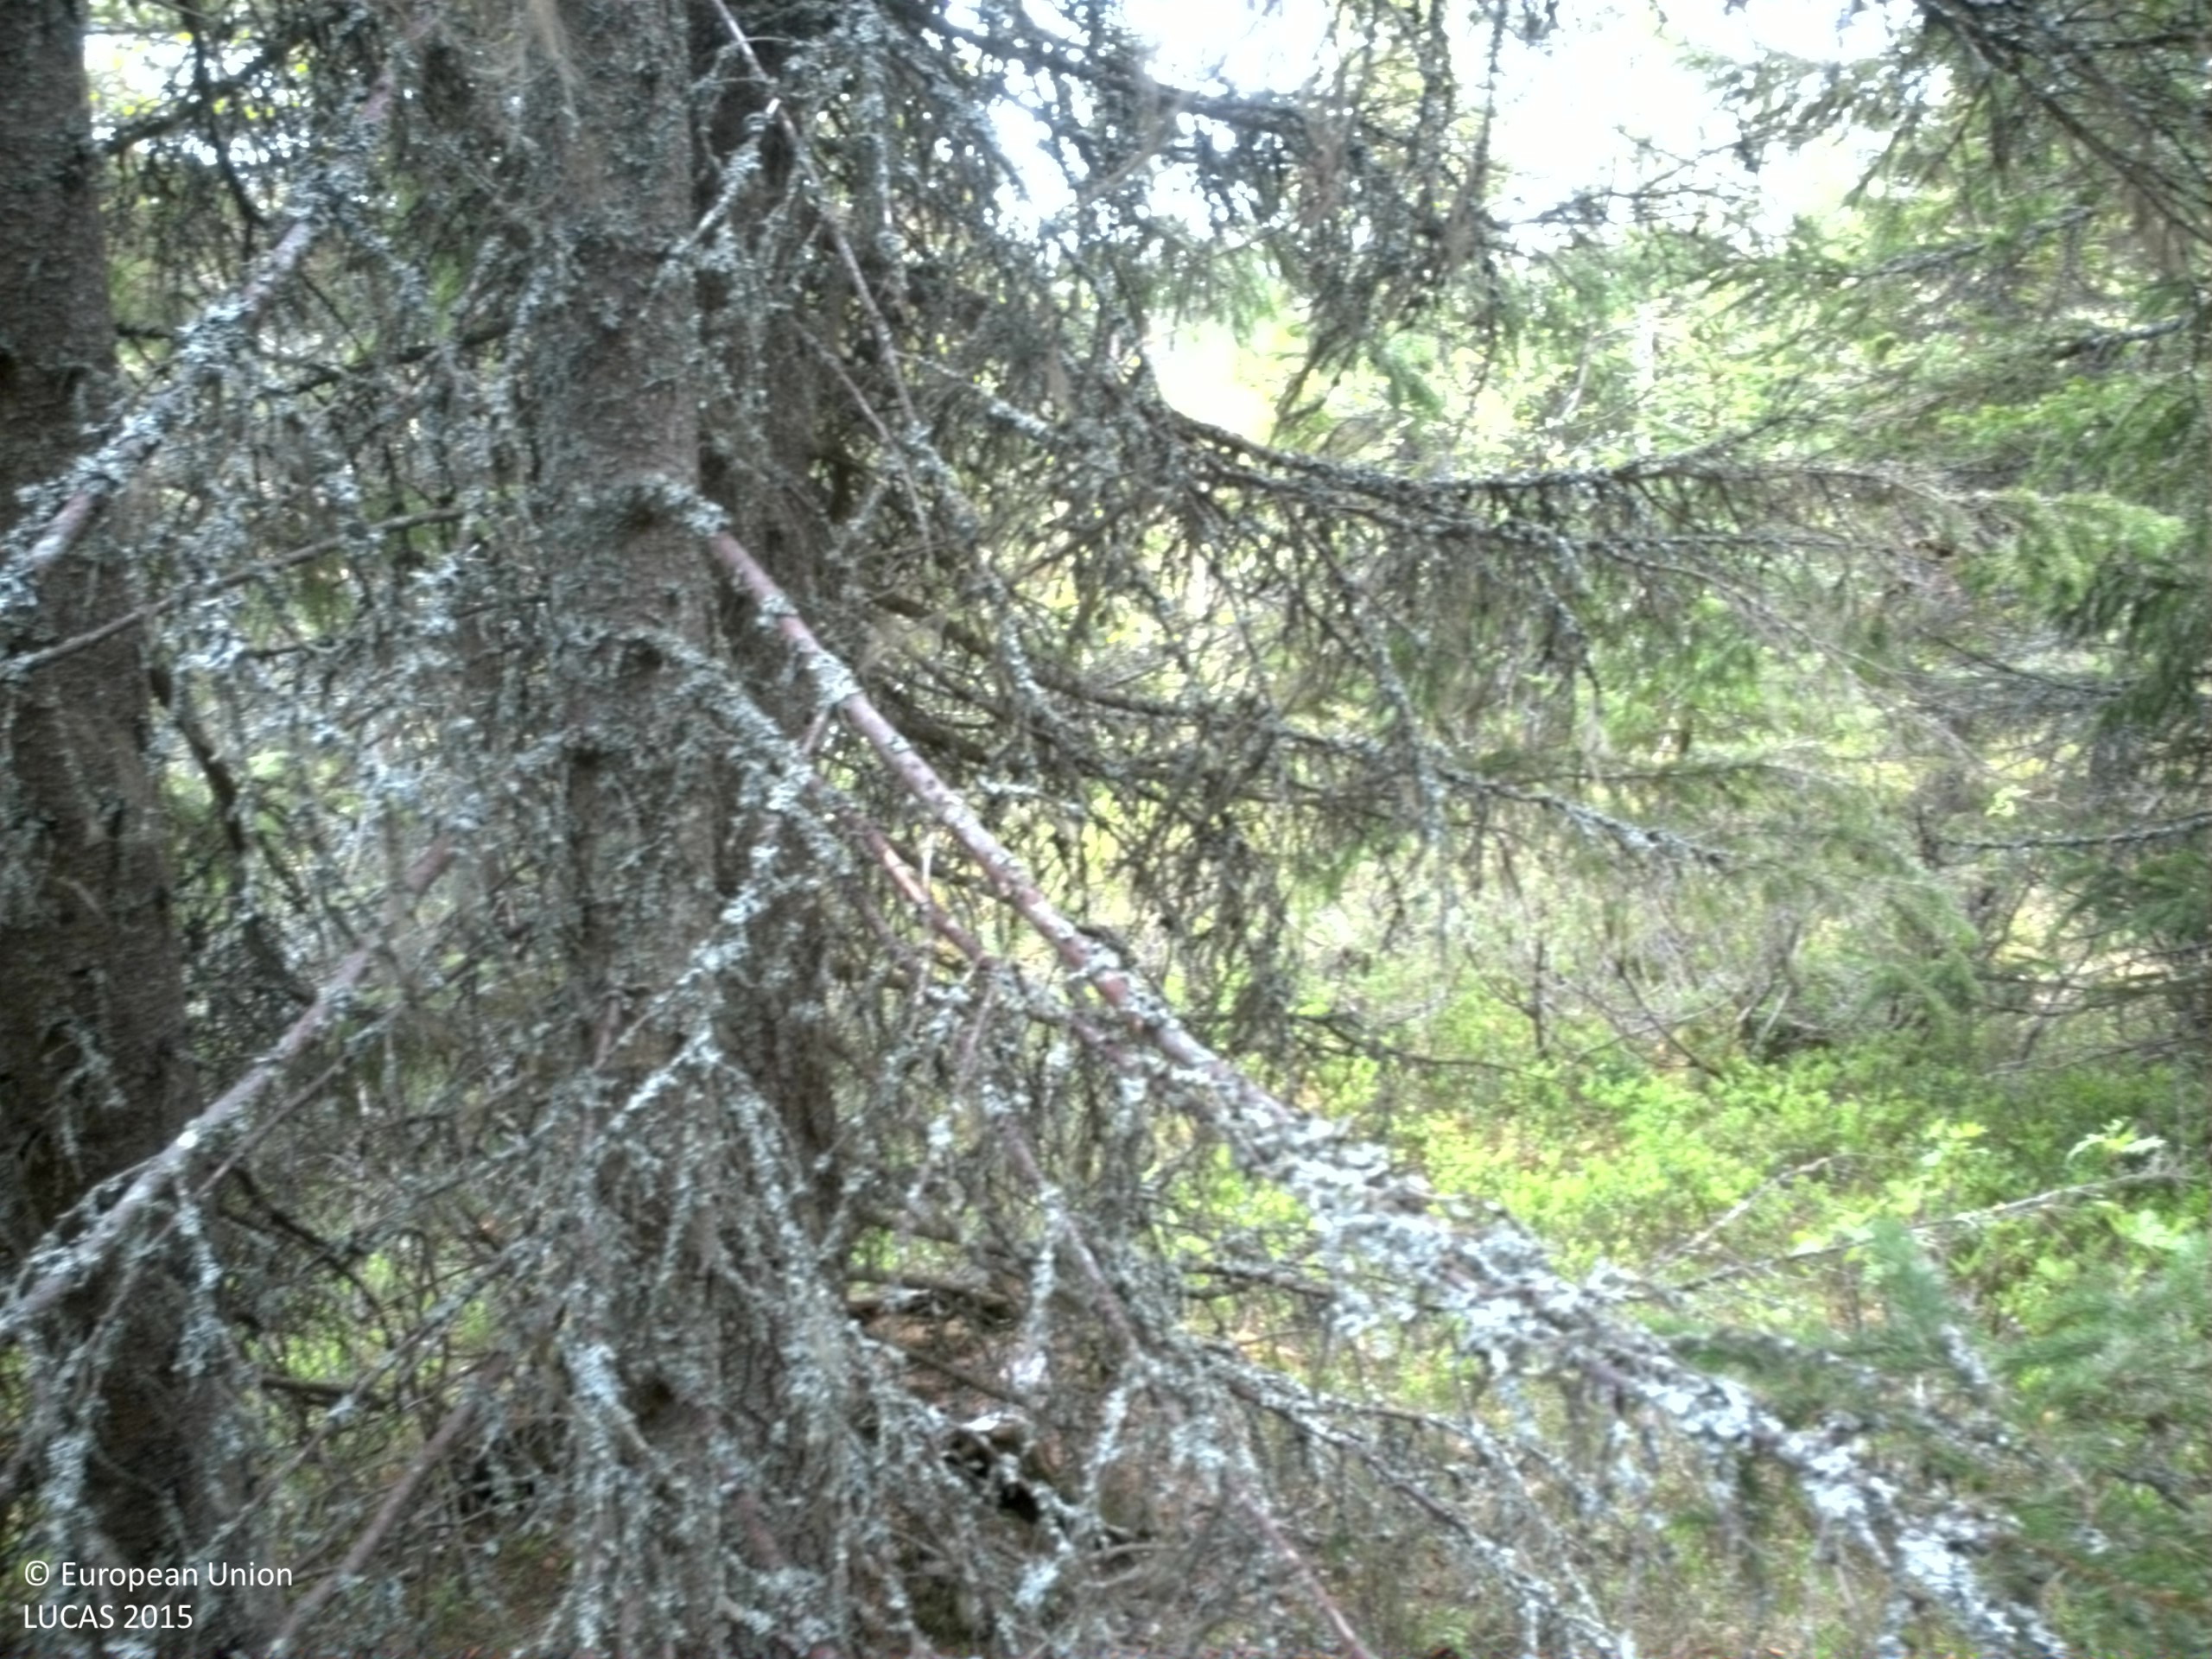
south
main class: Woodland
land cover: Spruce dominated mixed woodland
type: boreal forest
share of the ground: > 75 %
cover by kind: coniferous forest trees 60 %, broadleaved forest trees 20 %, shrubs 10 %, lichens and mosses 10 %
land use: Forestry
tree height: > 5 m
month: June
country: SE
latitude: 62.9432
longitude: 17.2879
